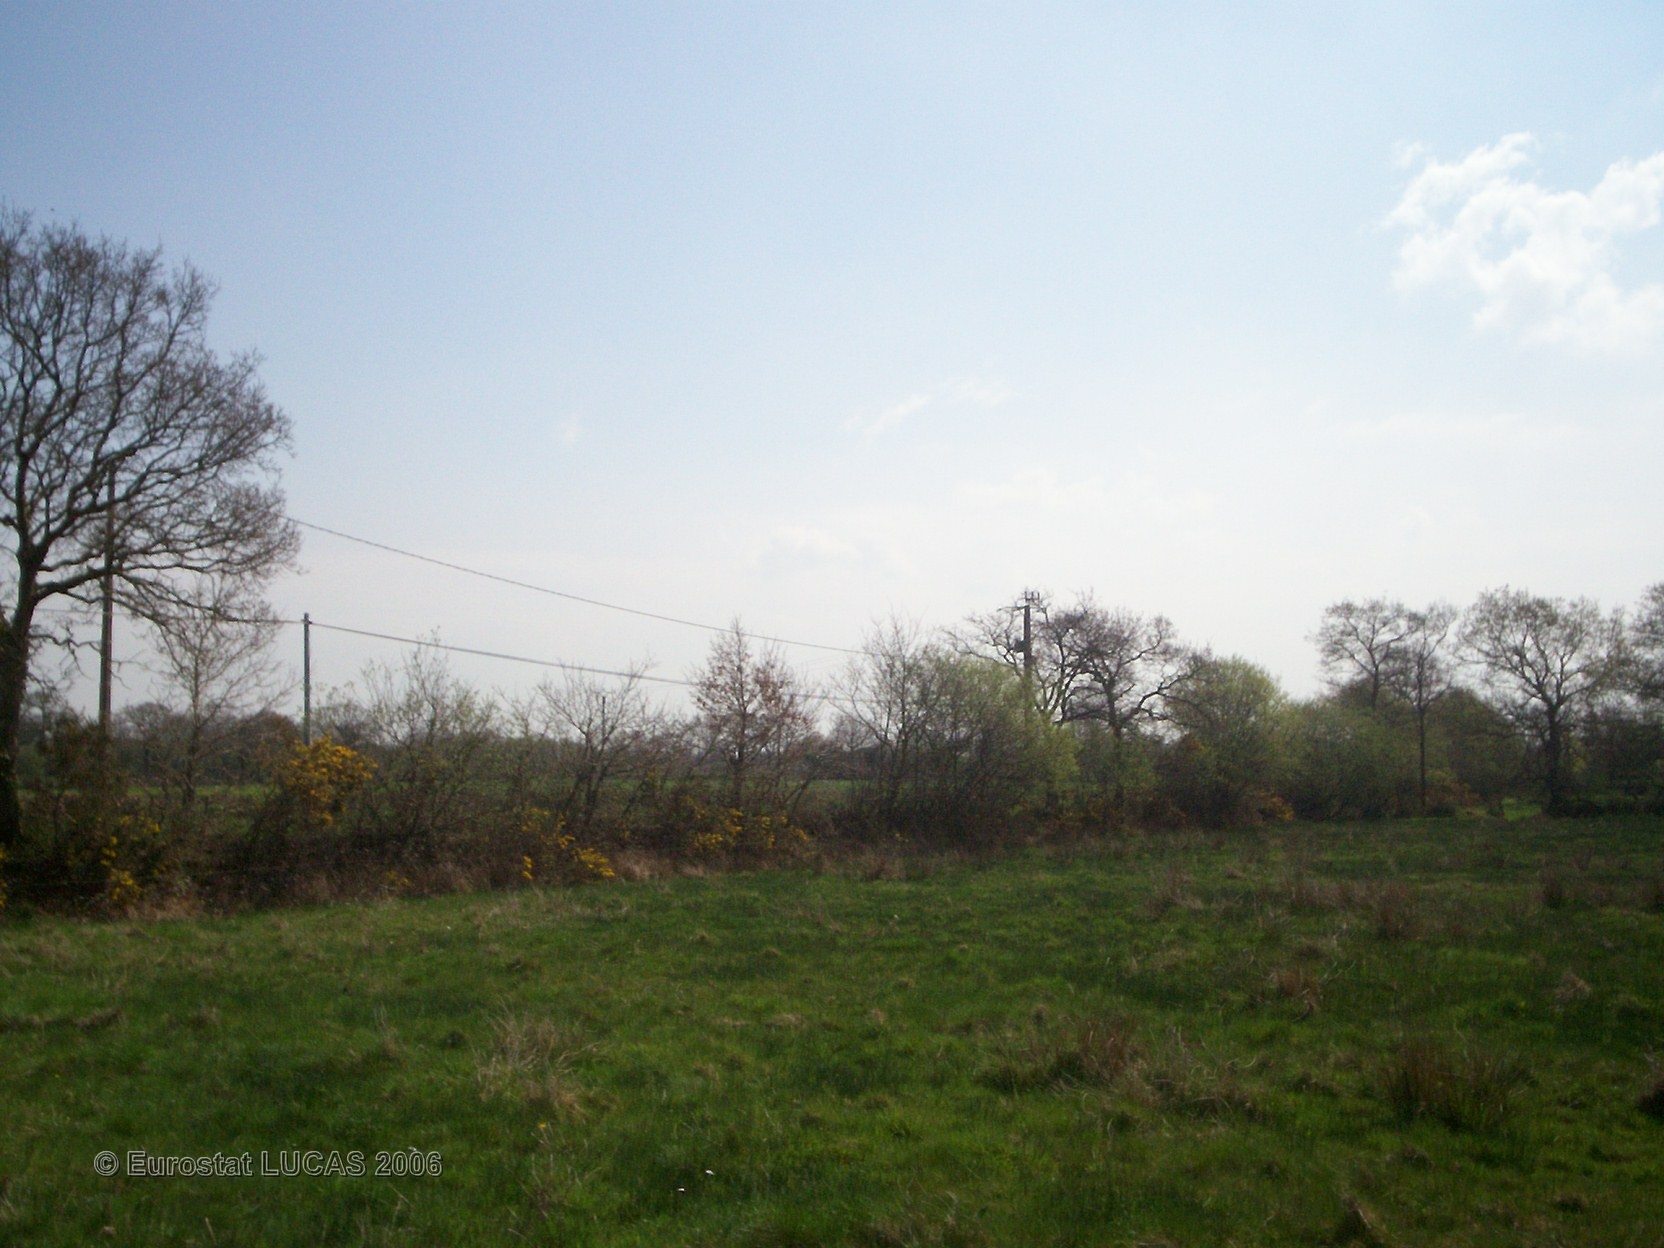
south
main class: Grassland
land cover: Grassland without tree/shrub cover
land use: Agriculture (excluding fallow land and kitchen gardens)
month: April
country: FR
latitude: 49.2052
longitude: -1.4541
